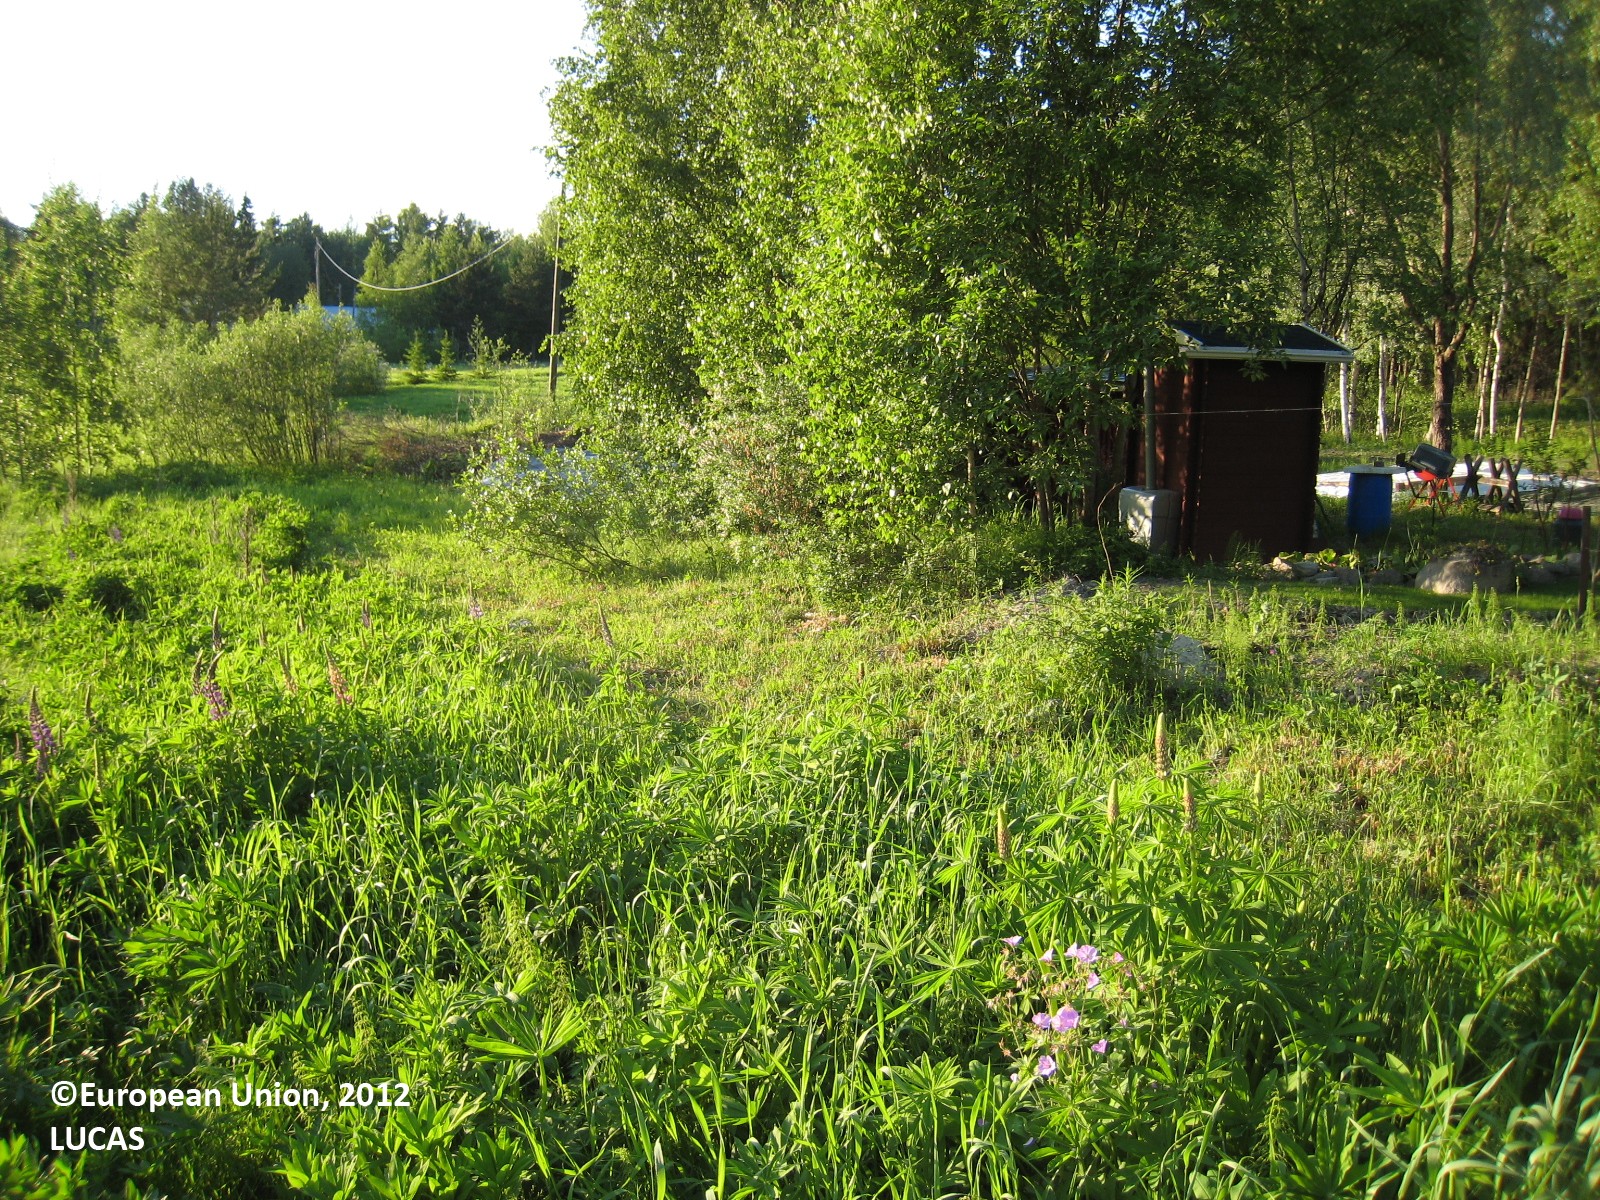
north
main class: Grassland
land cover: Spontaneously vegetated surfaces
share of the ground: > 75 %
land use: Fallow land
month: June
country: FI
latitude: 62.1318
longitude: 25.8685
